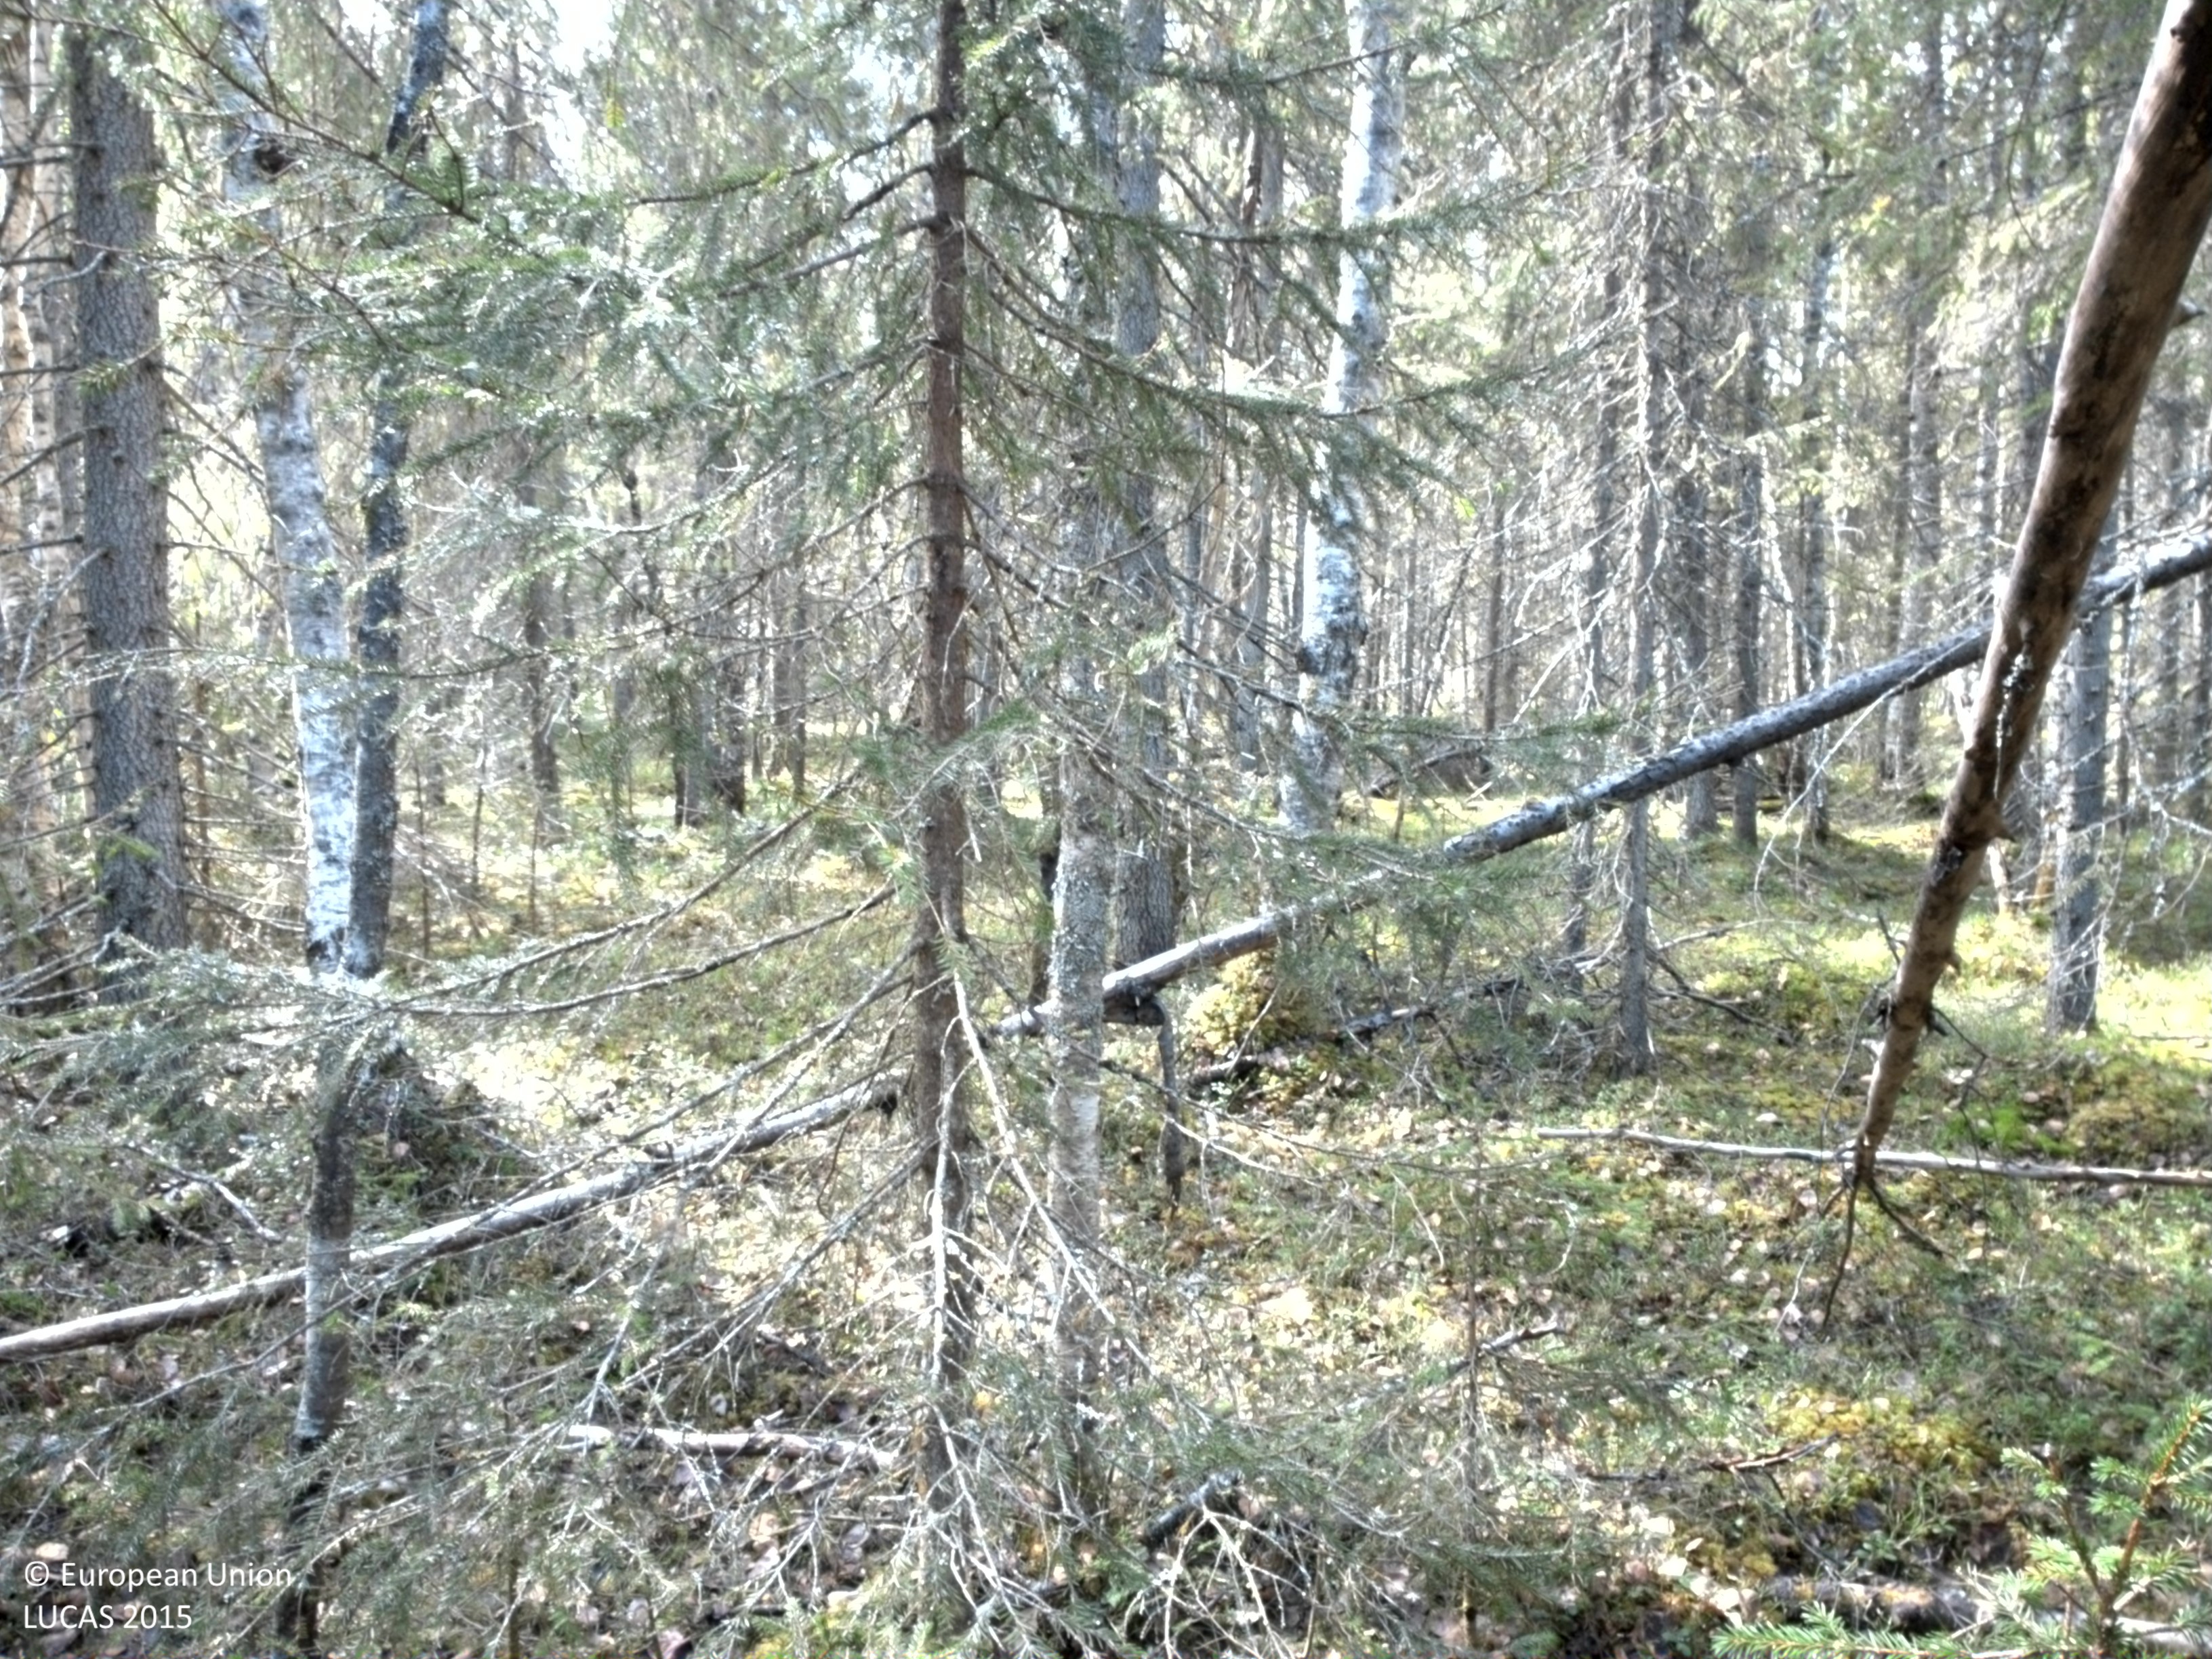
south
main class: Woodland
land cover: Spruce dominated coniferous woodland
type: boreal forest
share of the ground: > 75 %
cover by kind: coniferous forest trees 85 %, shrubs 10 %, broadleaved forest trees 5 %
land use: Forestry
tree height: > 5 m
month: May
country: SE
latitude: 66.1410
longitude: 23.2120
